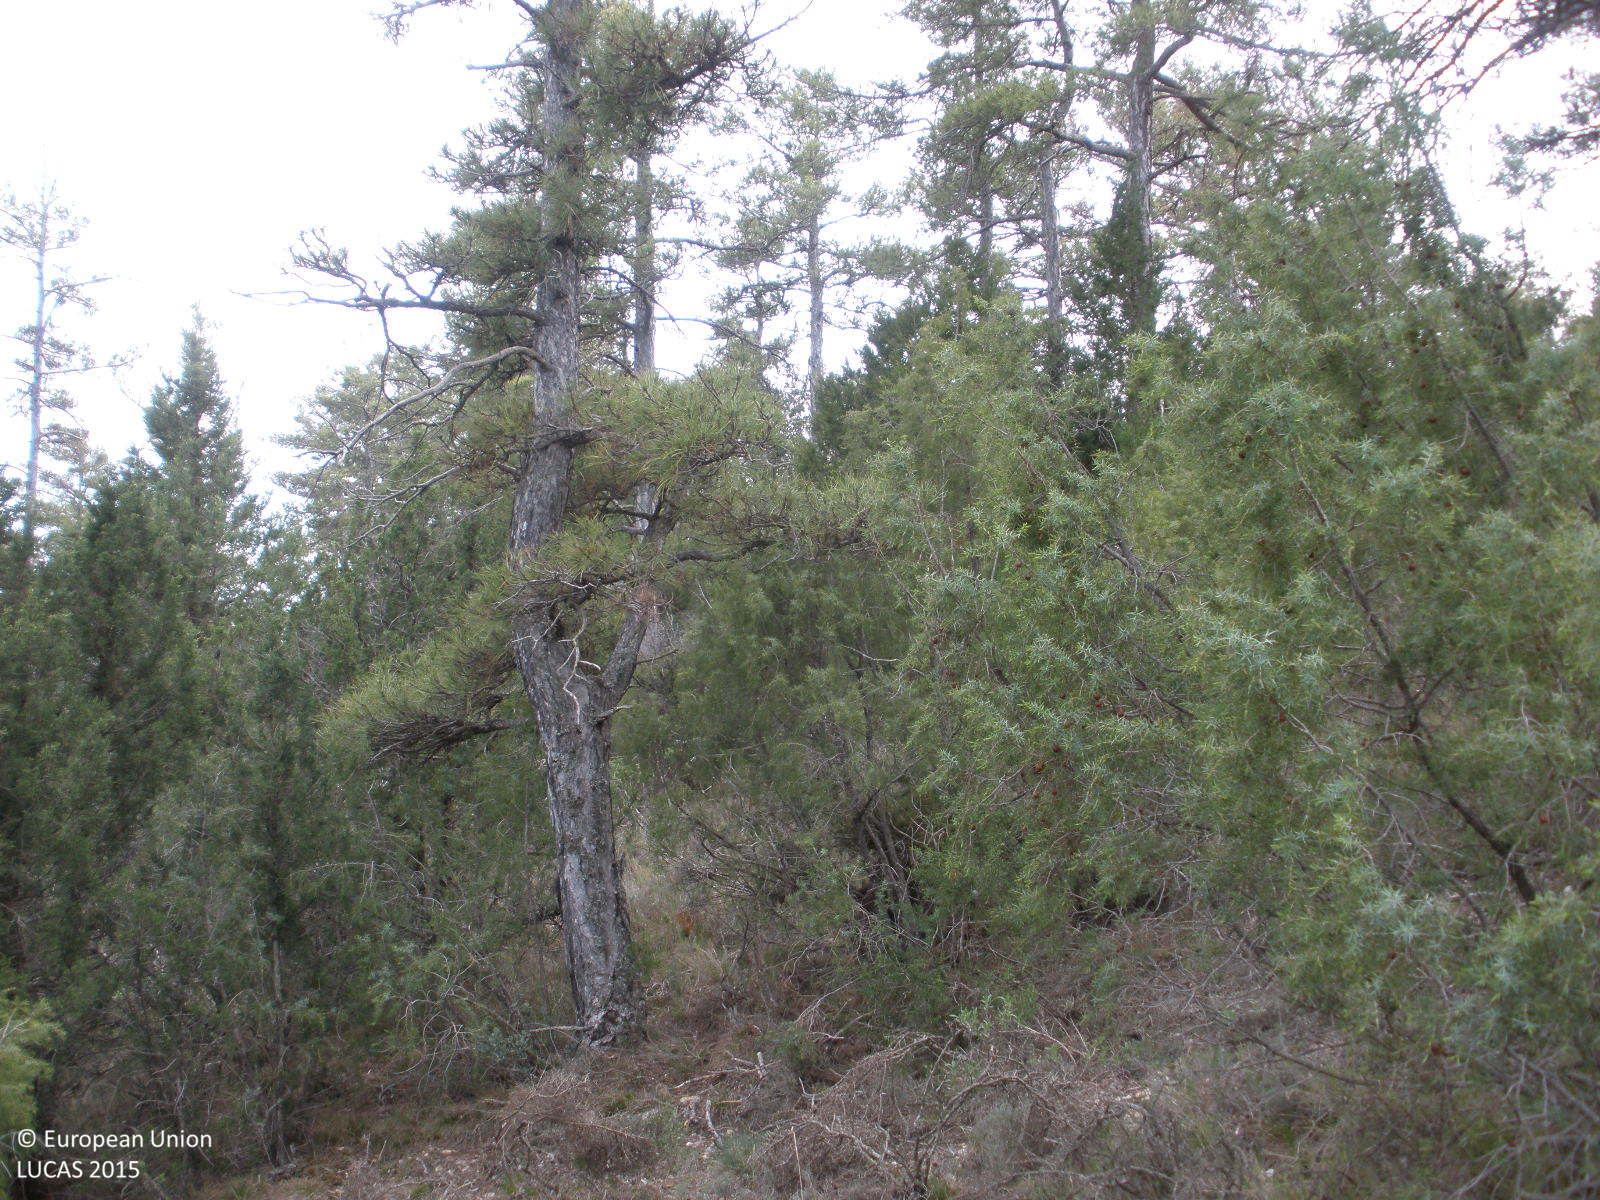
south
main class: Woodland
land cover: Pine dominated coniferous woodland
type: coniferous forest of the mediterranean region
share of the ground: > 75 %
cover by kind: coniferous forest trees 50 %, shrubs 40 %, consolidated bare surface 10 %
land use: Semi-natural and natural areas not in use
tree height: > 5 m
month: April
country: ES
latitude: 40.3766
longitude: -0.9993
